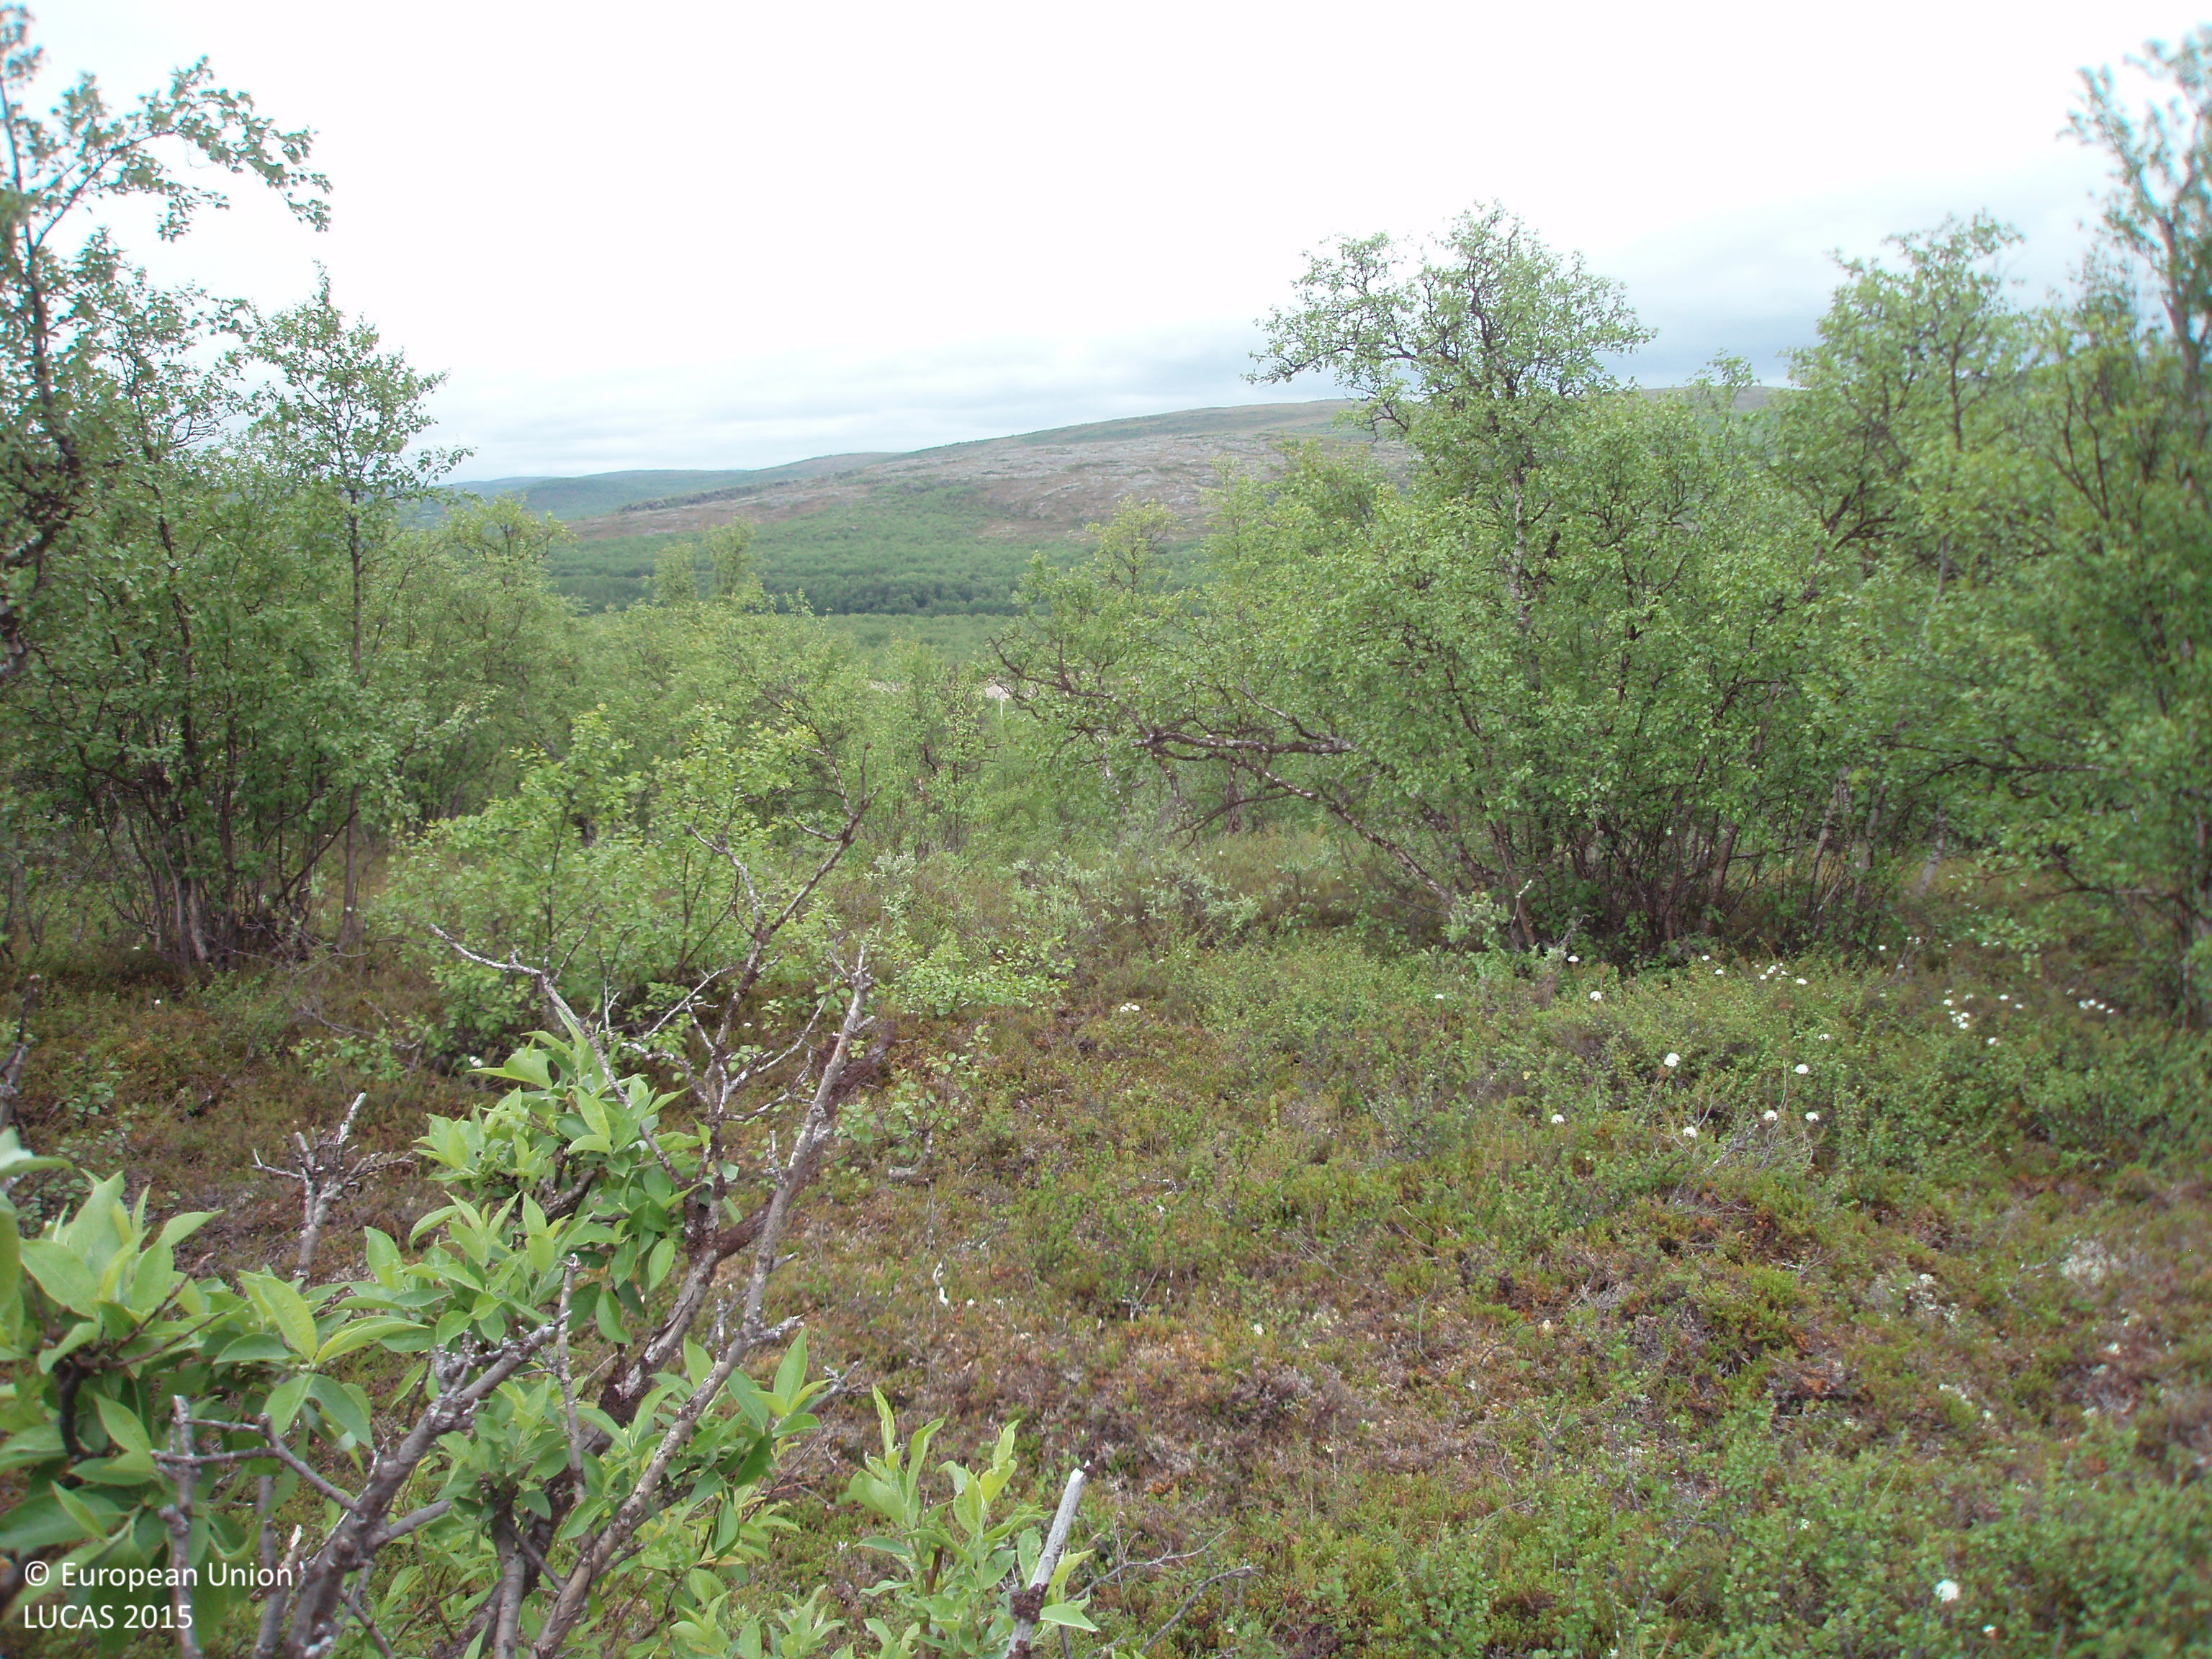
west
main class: Woodland
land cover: Broadleaved woodland
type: boreal forest
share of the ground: 25 - 50 %
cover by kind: broadleaved forest trees 45 %, shrubs 45 %, lichens and mosses 10 %
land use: Forestry
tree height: > 5 m
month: July
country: FI
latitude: 70.0248
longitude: 27.5466
